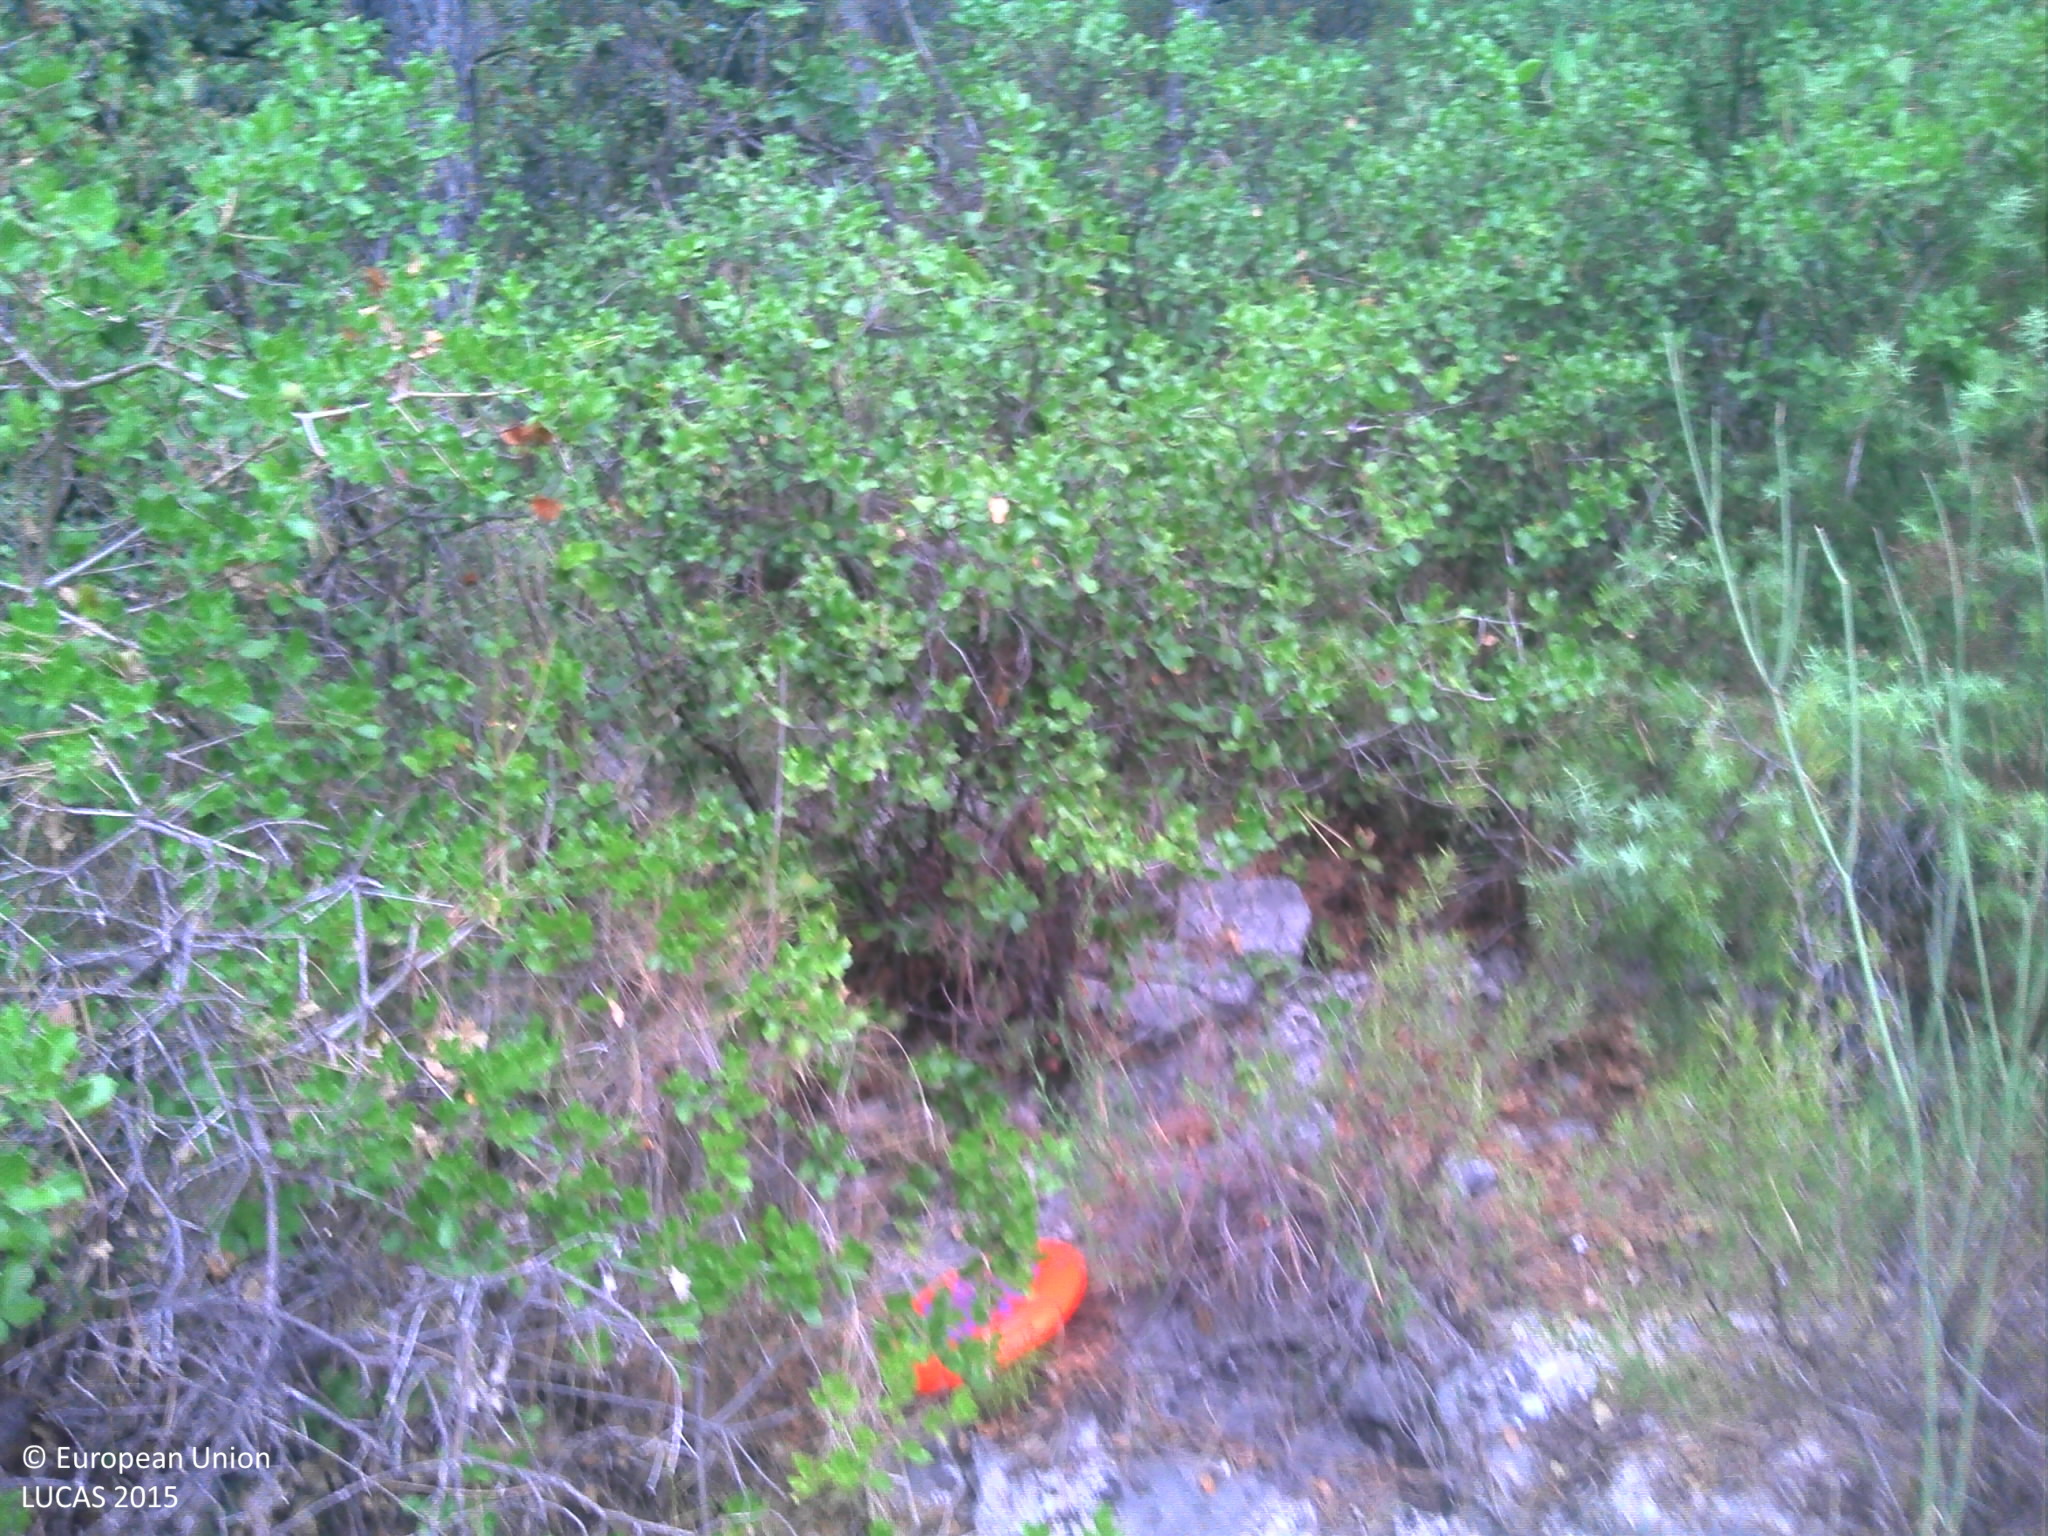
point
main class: Woodland
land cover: Pine dominated coniferous woodland
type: coniferous forest of the mediterranean region
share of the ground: > 75 %
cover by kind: coniferous forest trees 60 %, shrubs 20 %, unconsolidated bare surface 15 %, herbaceous plants 5 %
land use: Forestry
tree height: > 5 m
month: August
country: FR
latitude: 43.3563
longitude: 5.6546
